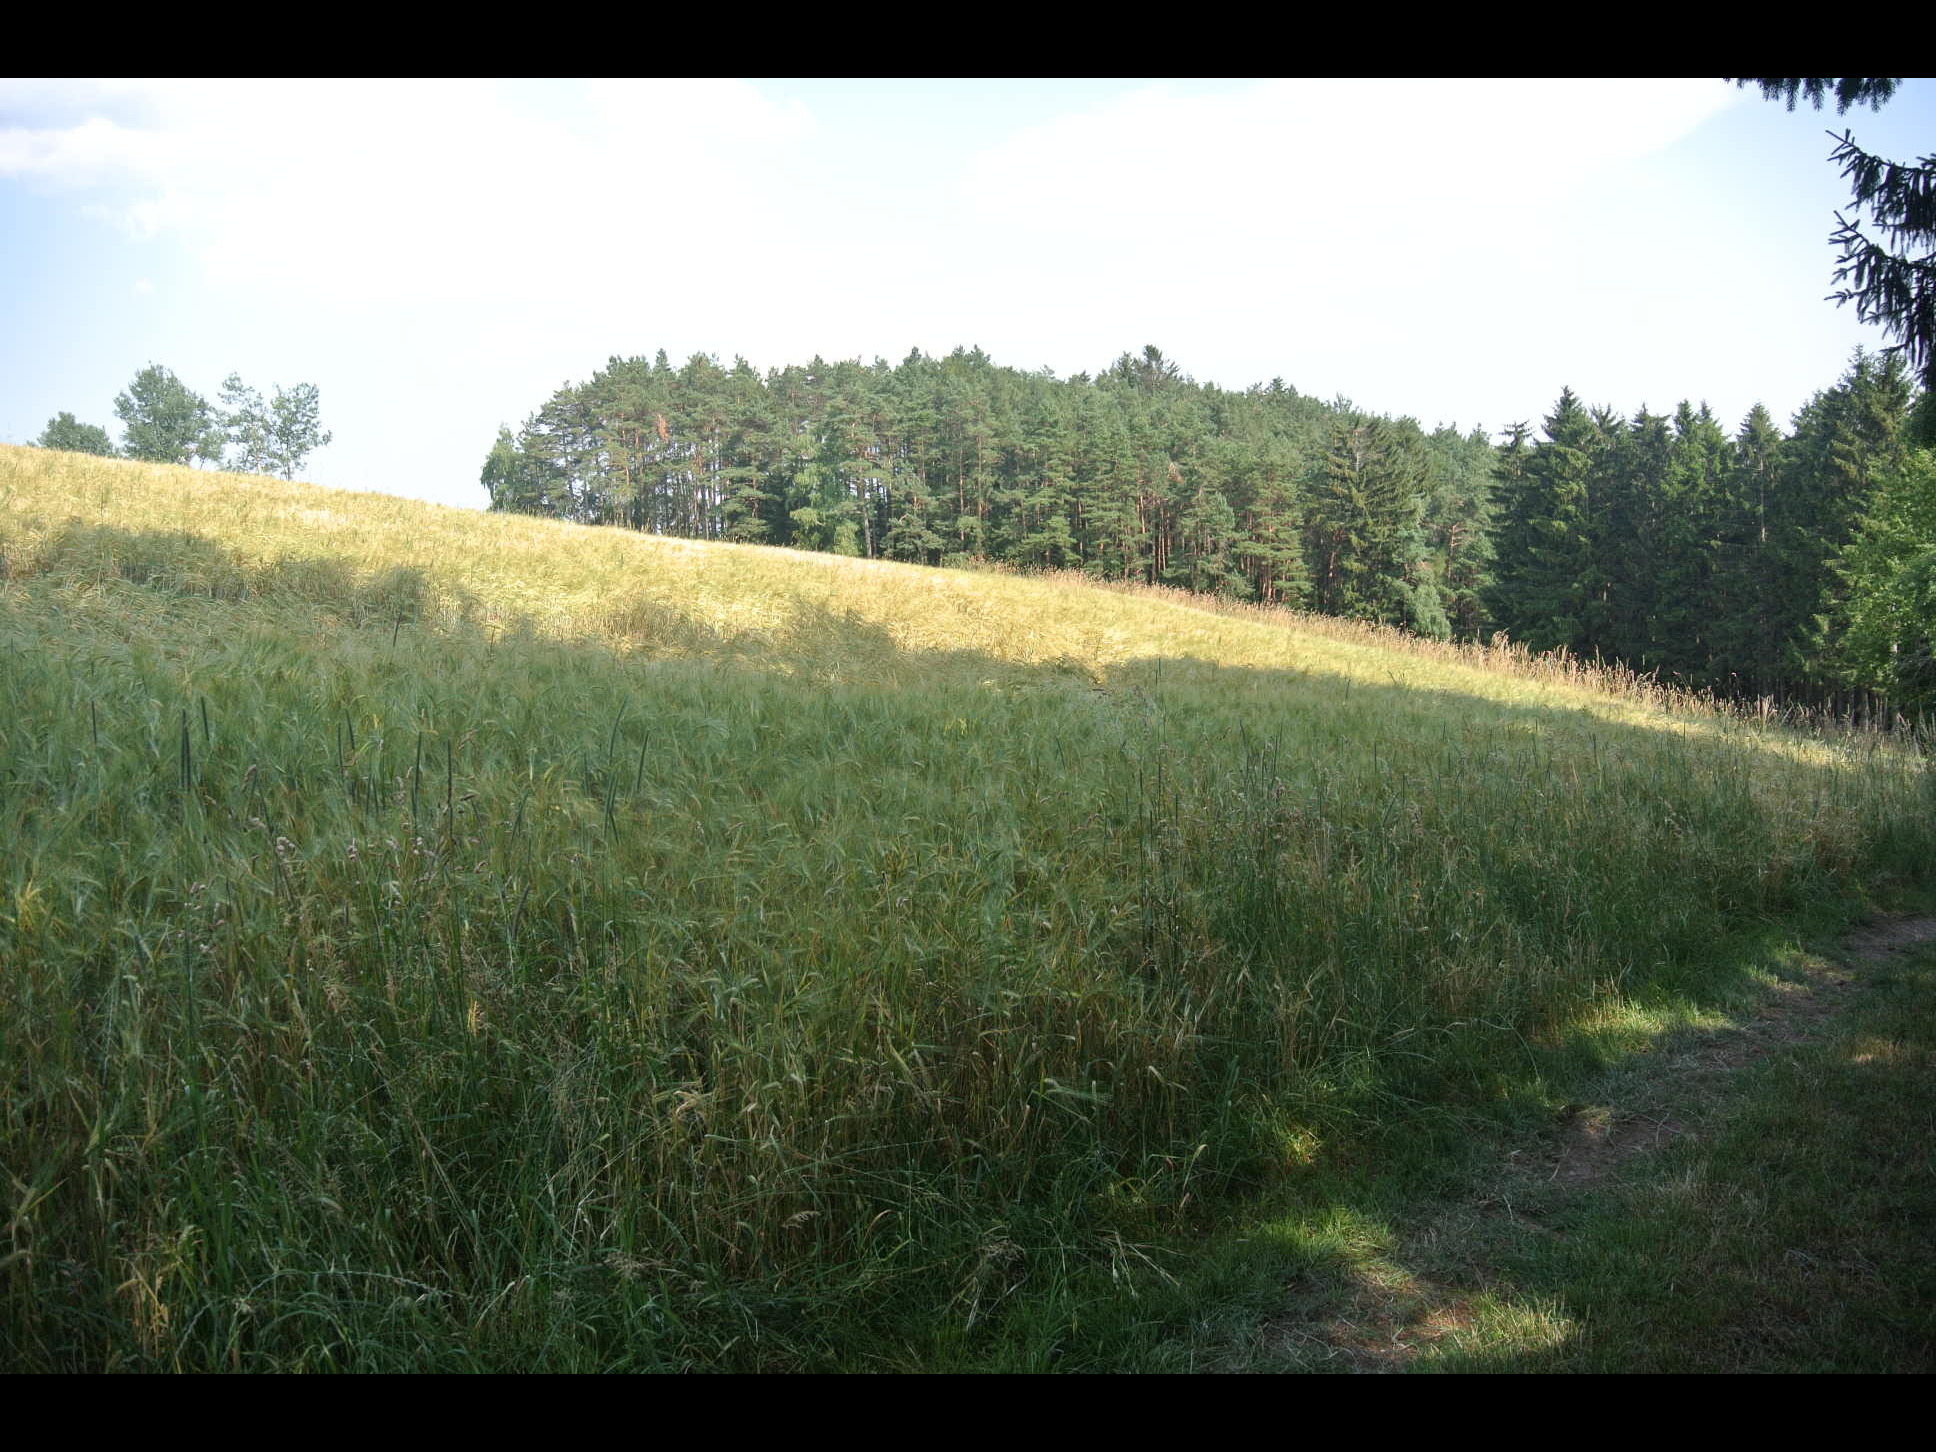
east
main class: Woodland
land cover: Broadleaved woodland
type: floodplain forest
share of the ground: > 75 %
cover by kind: broadleaved forest trees 100 %
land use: Forestry
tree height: > 5 m
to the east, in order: Broadleaved woodland; Rivers and streams; Broadleaved woodland; Spruce dominated mixed woodland; Tracks; Rye; Tracks; Broadleaved woodland; Temporary grasslands
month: July
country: AT
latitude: 47.5626
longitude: 16.1832
